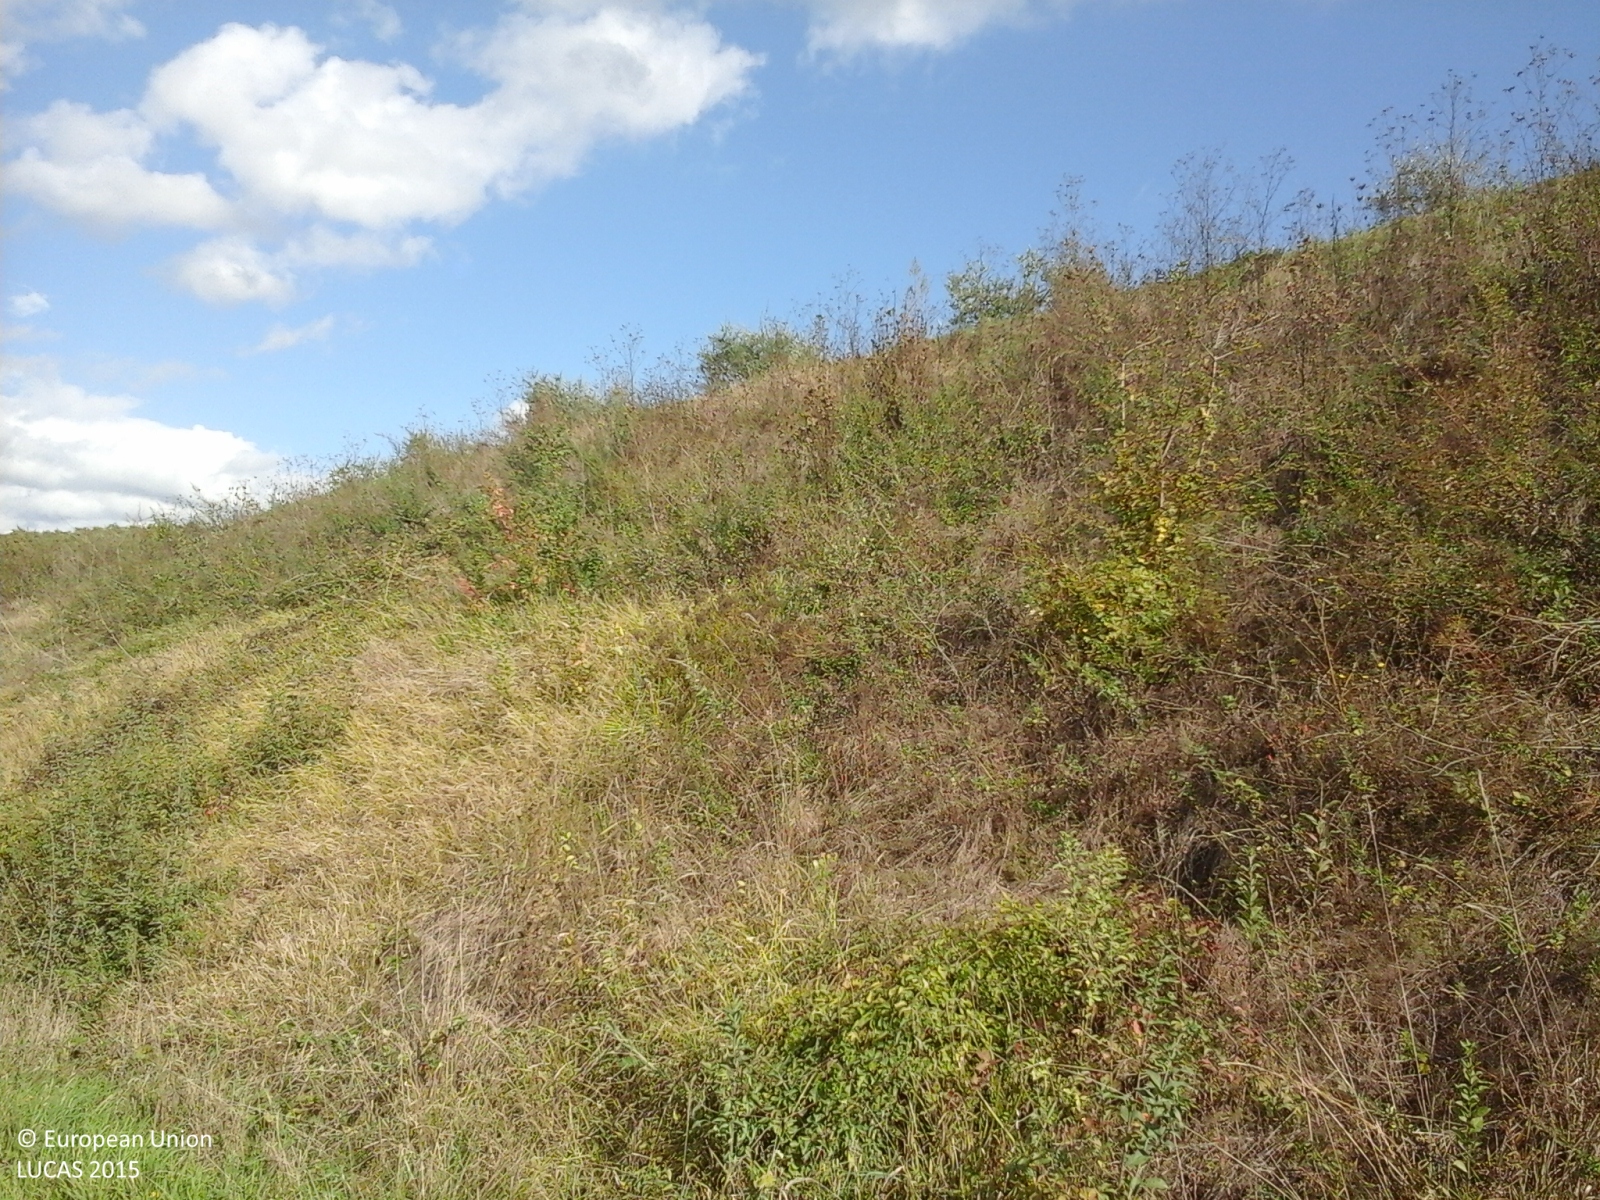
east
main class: Shrubland
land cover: Shrubland without tree cover
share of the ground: 50 - 75 %
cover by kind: shrubs 70 %, herbaceous plants 30 %
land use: Abandoned areas
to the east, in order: Shrubland without tree cover; Olive groves; Tracks; Grass margins; Abandoned hedges; Fences; Grassland with sparse tree/shrub cover; Broadleaved woodland; Grassland with sparse tree/shrub cover; Broadleaved woodland; Grassland with sparse tree/shrub cover; Broadleaved woodland; Electric lines; Fences; Broadleaved woodland
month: October
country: IT
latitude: 43.2974
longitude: 12.2494
